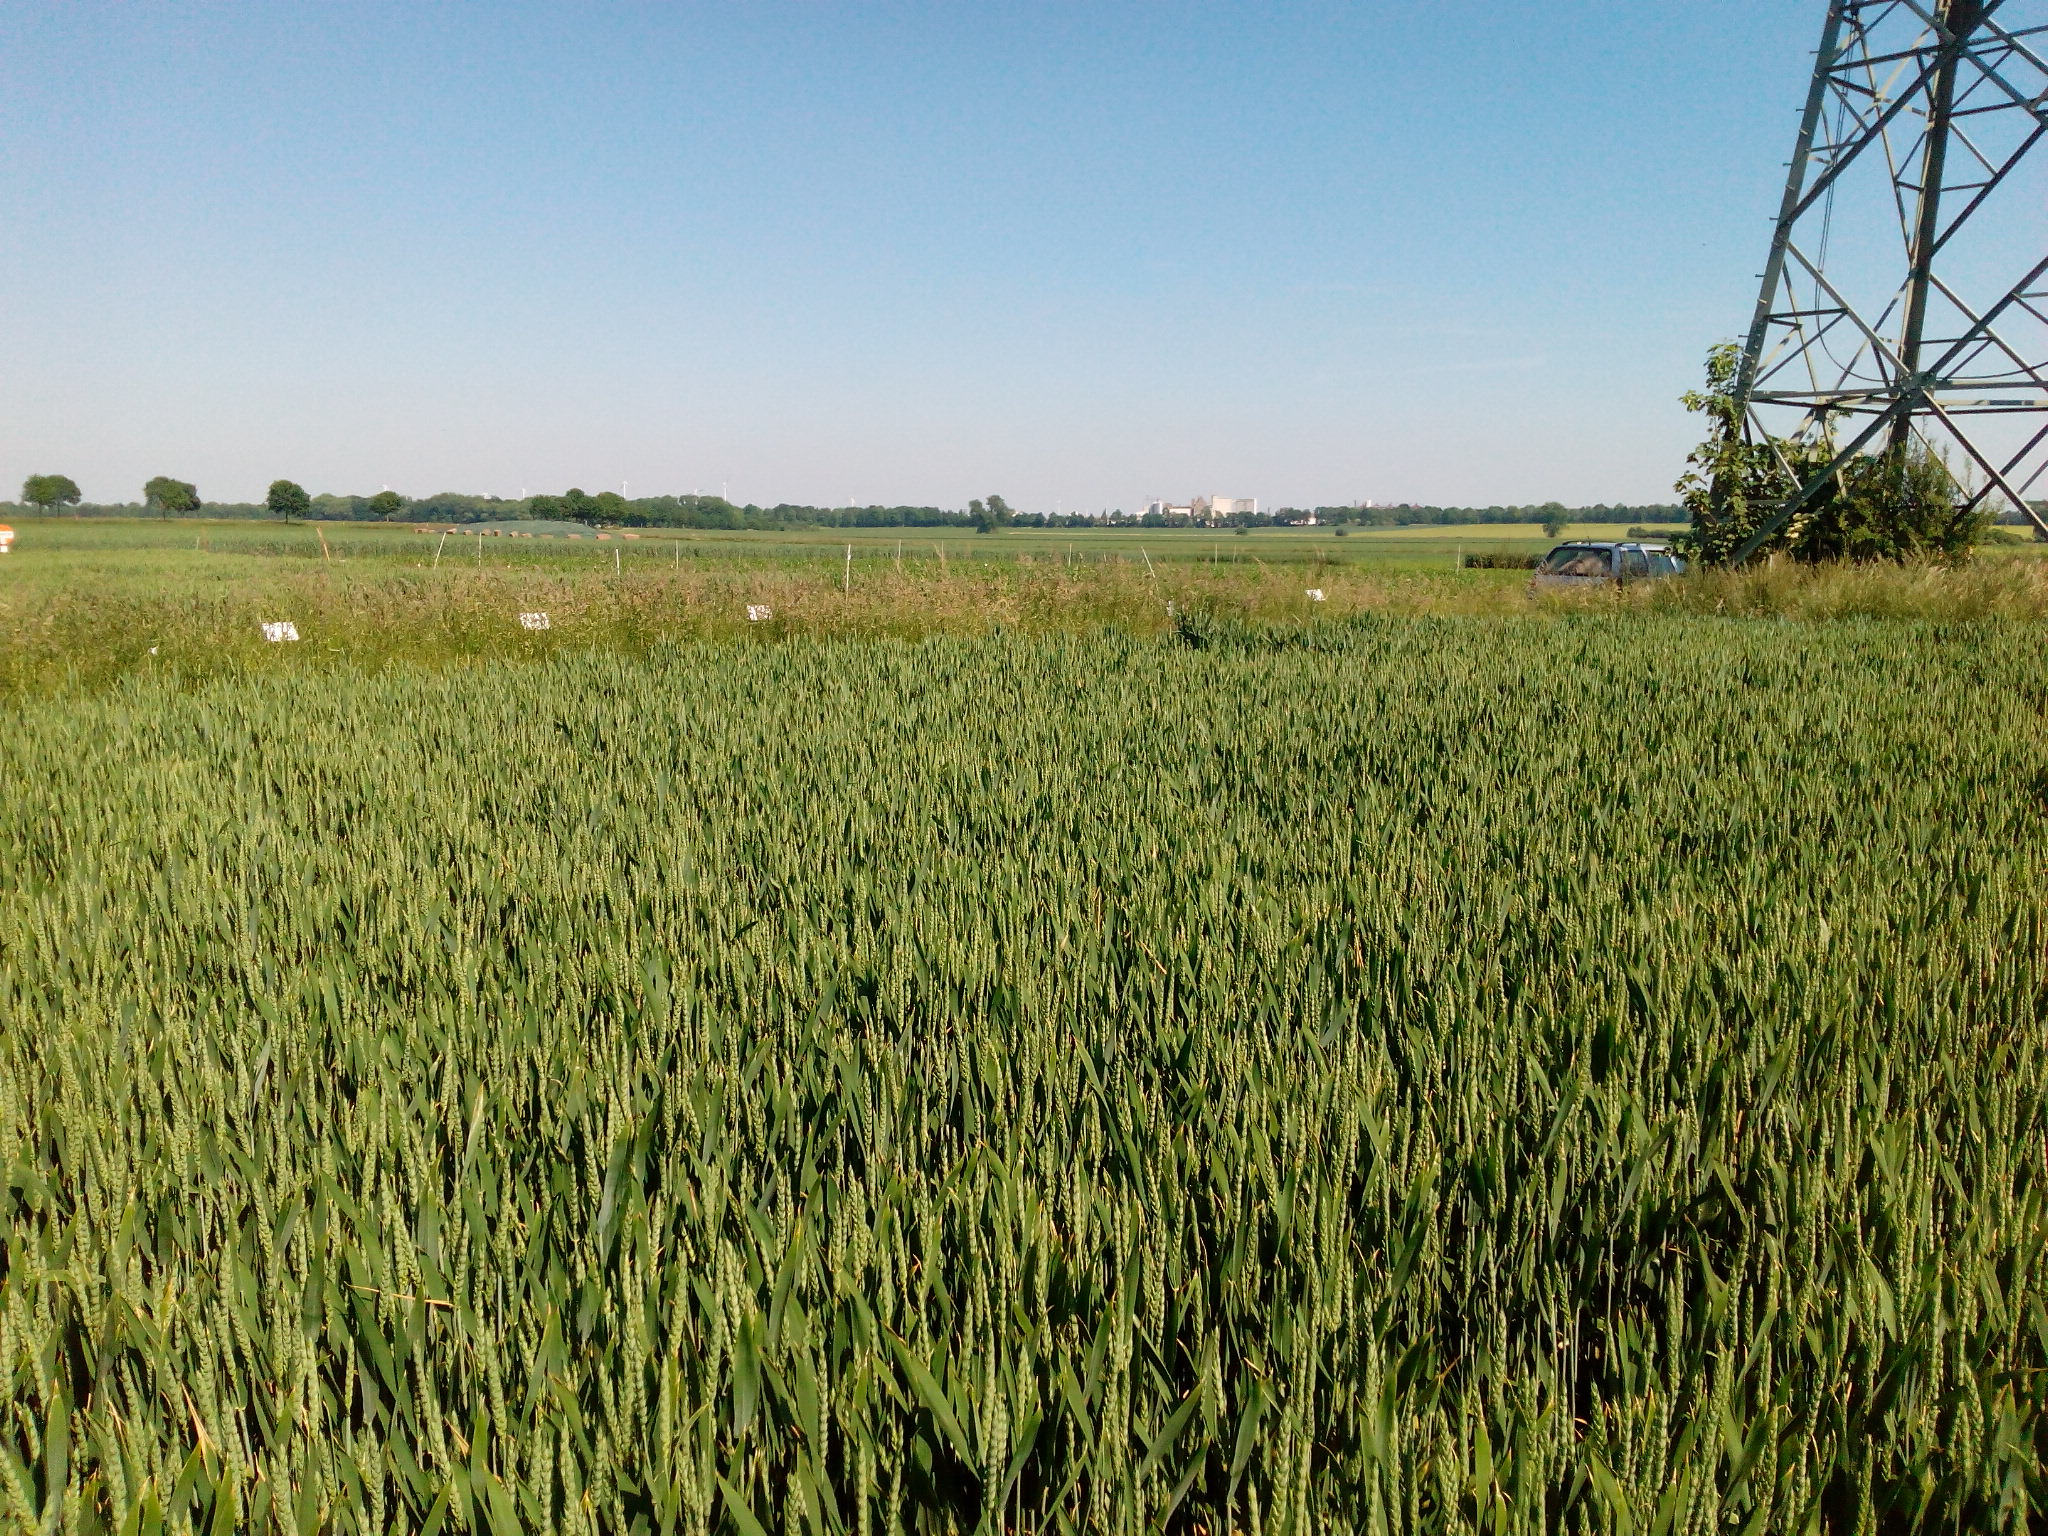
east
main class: Cropland
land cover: Common wheat
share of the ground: > 75 %
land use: Agriculture (excluding fallow land and kitchen gardens)
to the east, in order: Common wheat; Grass margins; Electric lines; Tracks; Grass margins; Maize; Grass margins; Maize; Grass margins; Maize; Common wheat; Maize
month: June
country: DE
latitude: 52.2516
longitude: 9.9268
